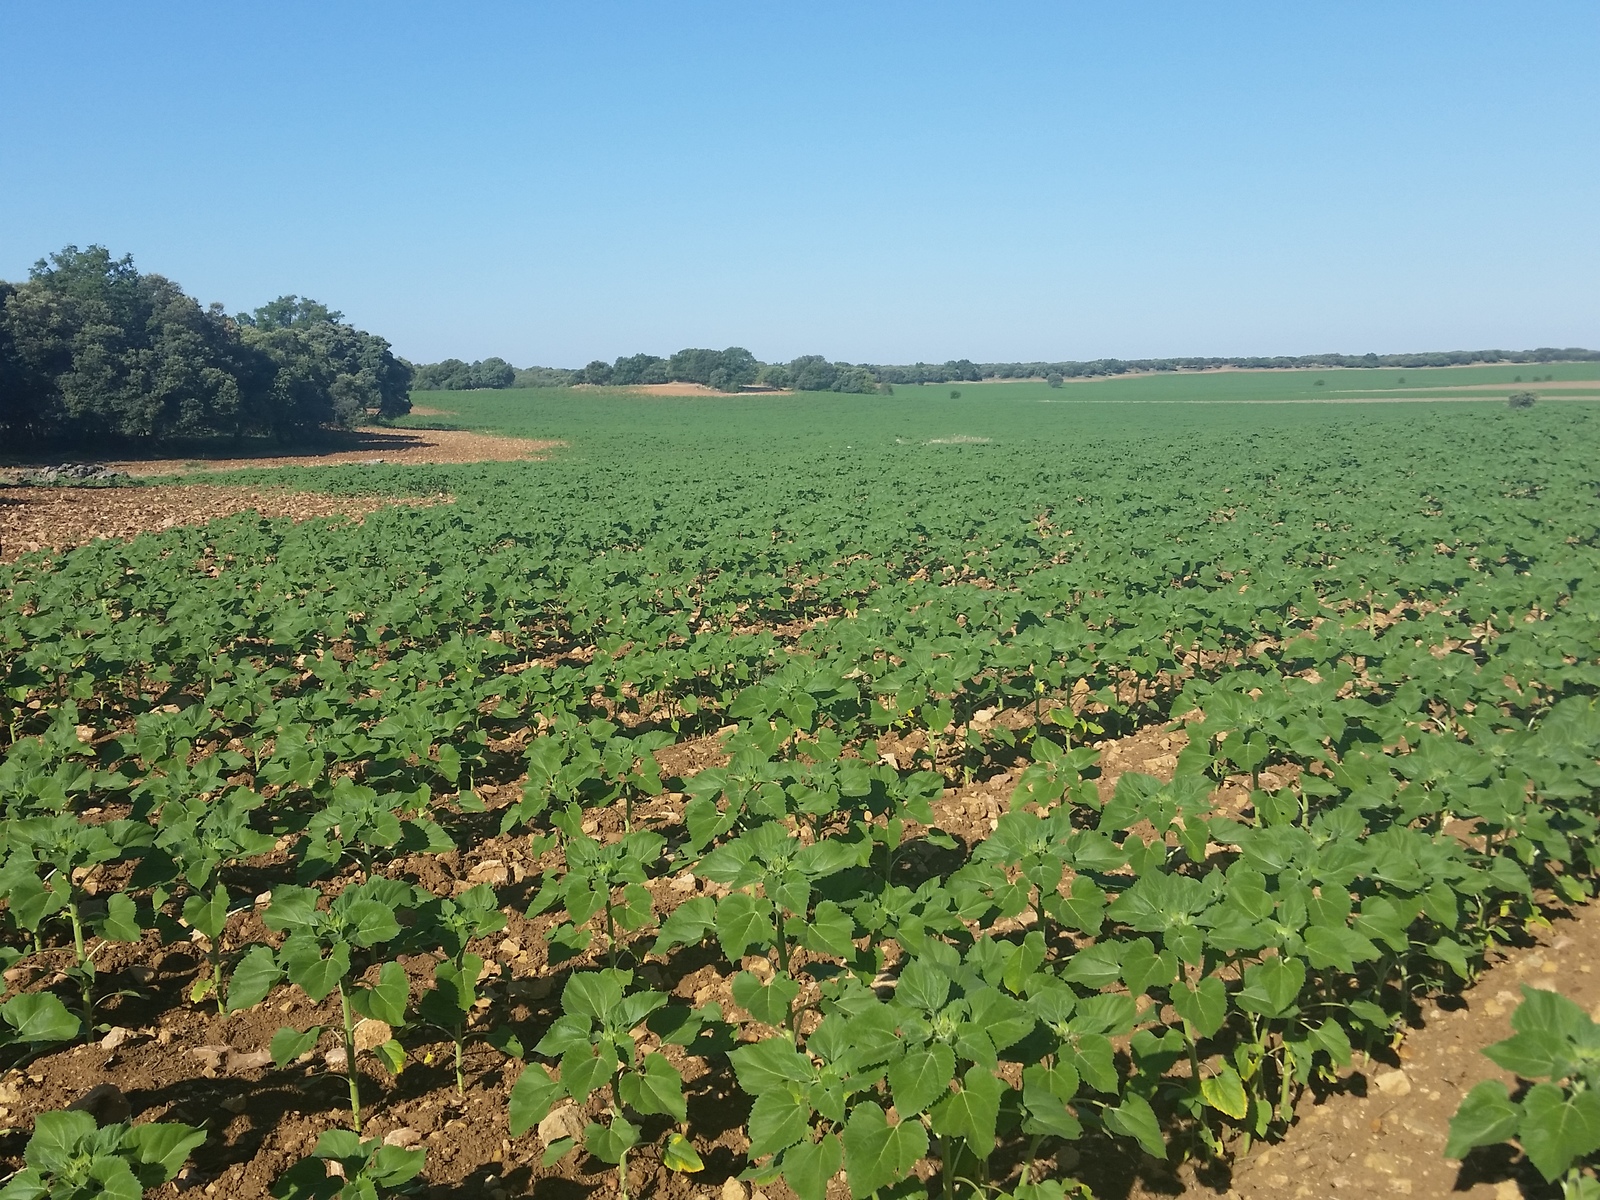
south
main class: Cropland
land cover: Sunflower
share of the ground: > 75 %
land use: Agriculture (excluding fallow land and kitchen gardens)
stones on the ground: 10 - 25 %
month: June
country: ES
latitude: 38.7348
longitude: -2.4837
